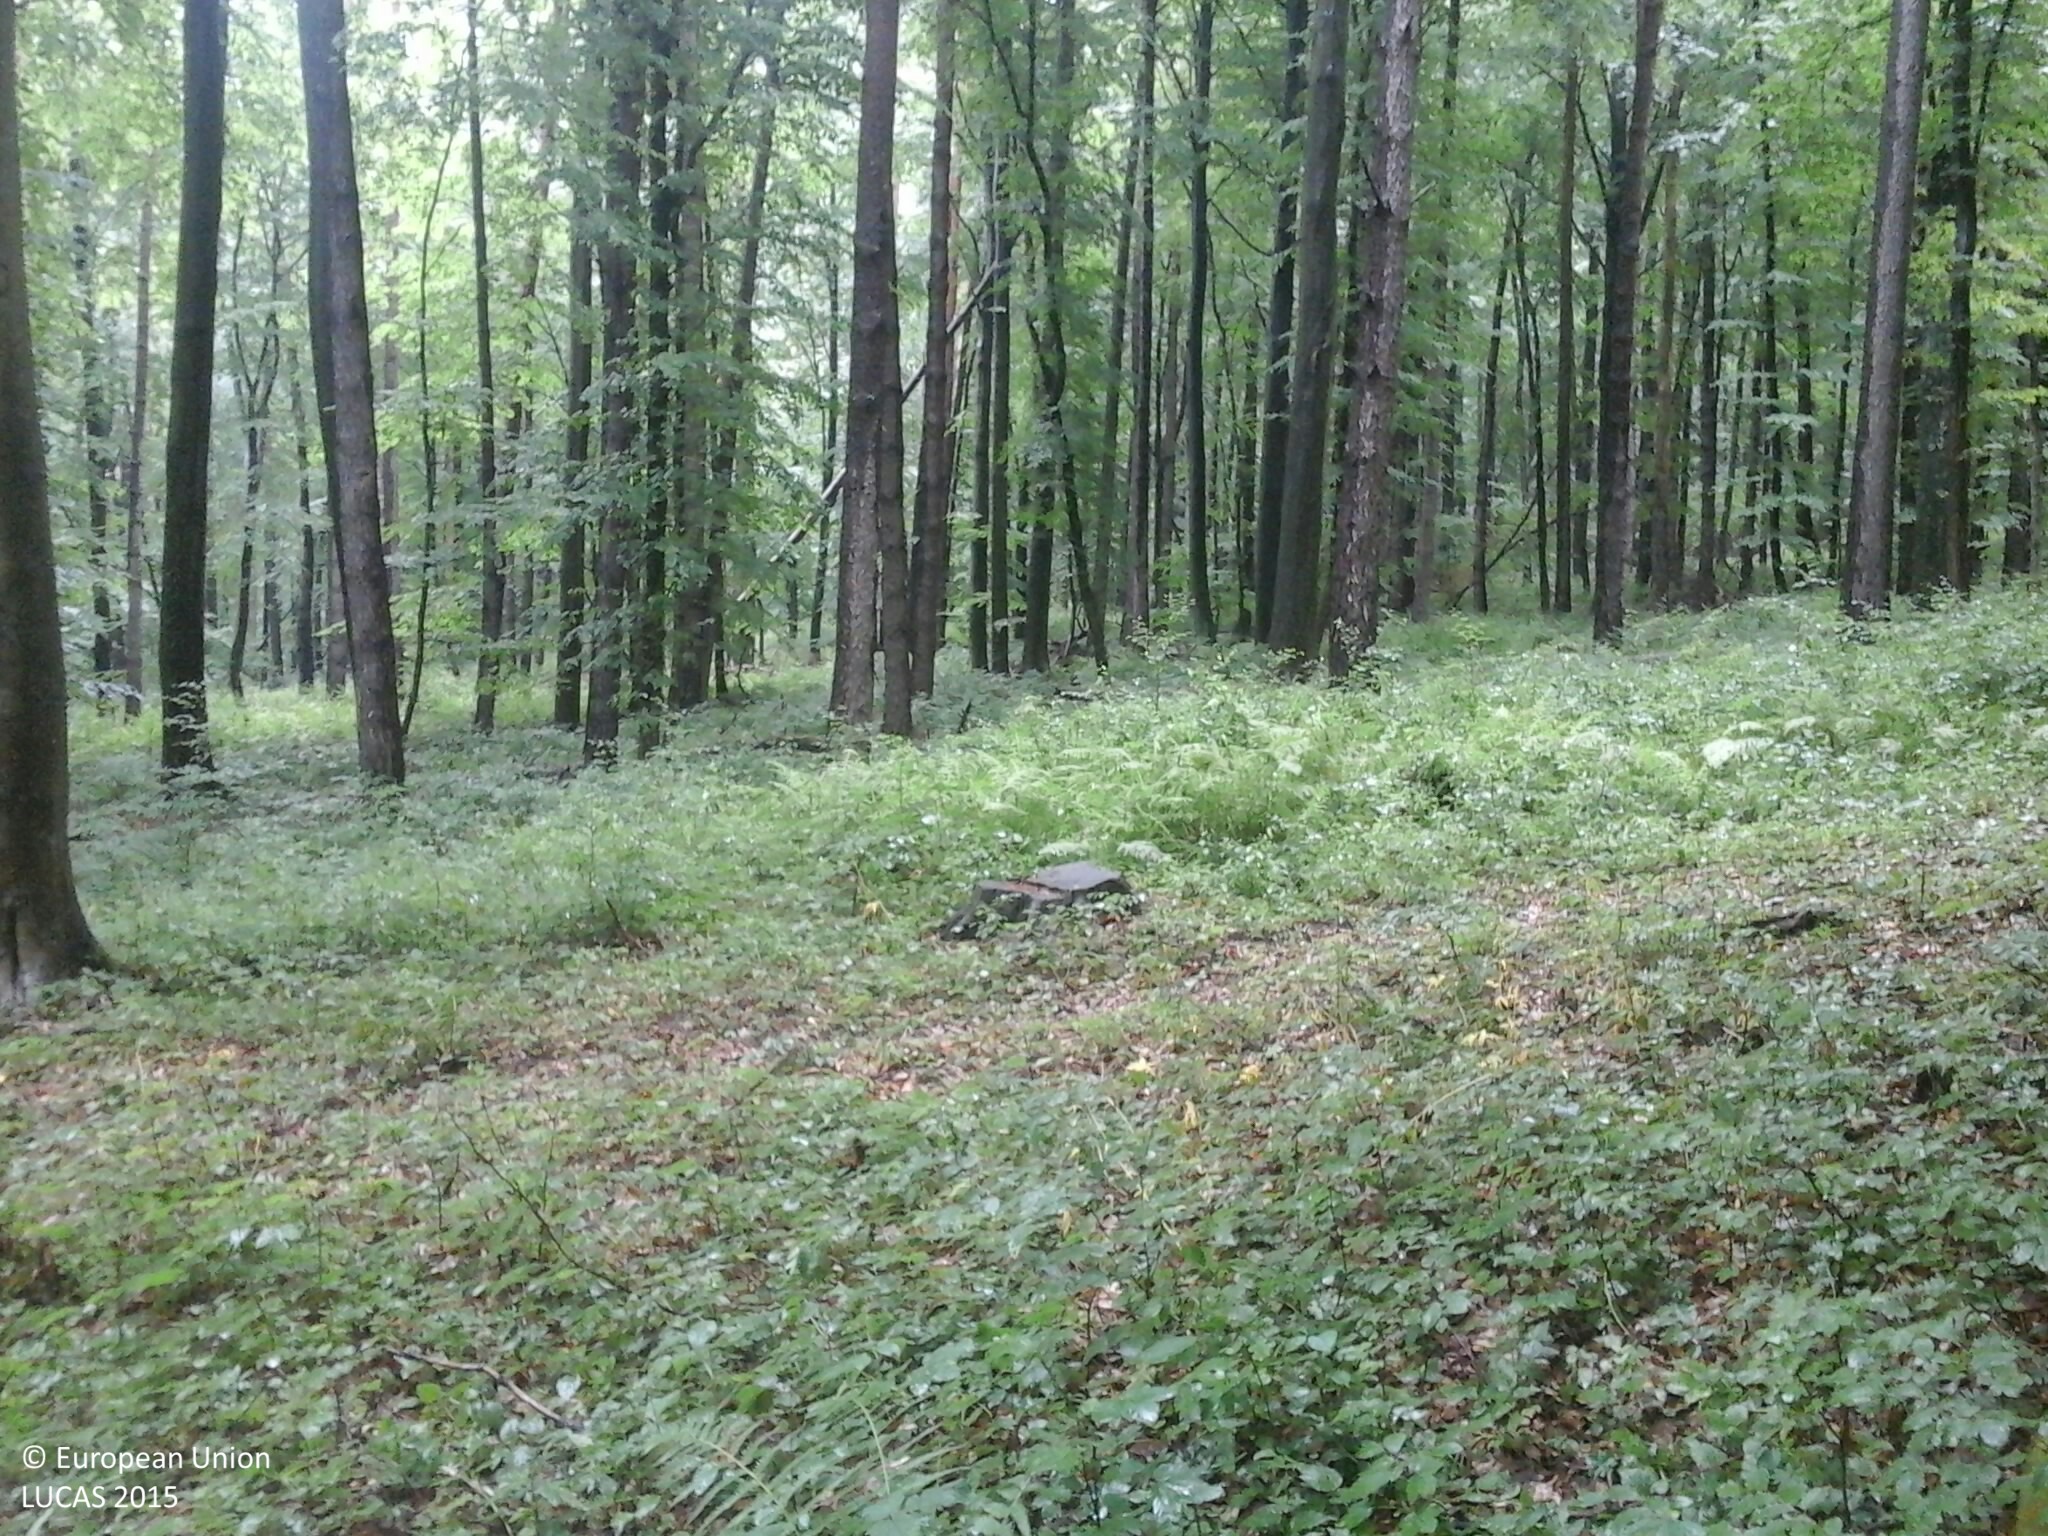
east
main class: Woodland
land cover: Broadleaved woodland
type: beech forest
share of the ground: > 75 %
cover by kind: broadleaved forest trees 80 %, shrubs 10 %, herbaceous plants 10 %
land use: Forestry
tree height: > 5 m
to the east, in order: Broadleaved woodland
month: July
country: HU
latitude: 46.5862
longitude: 16.5138
